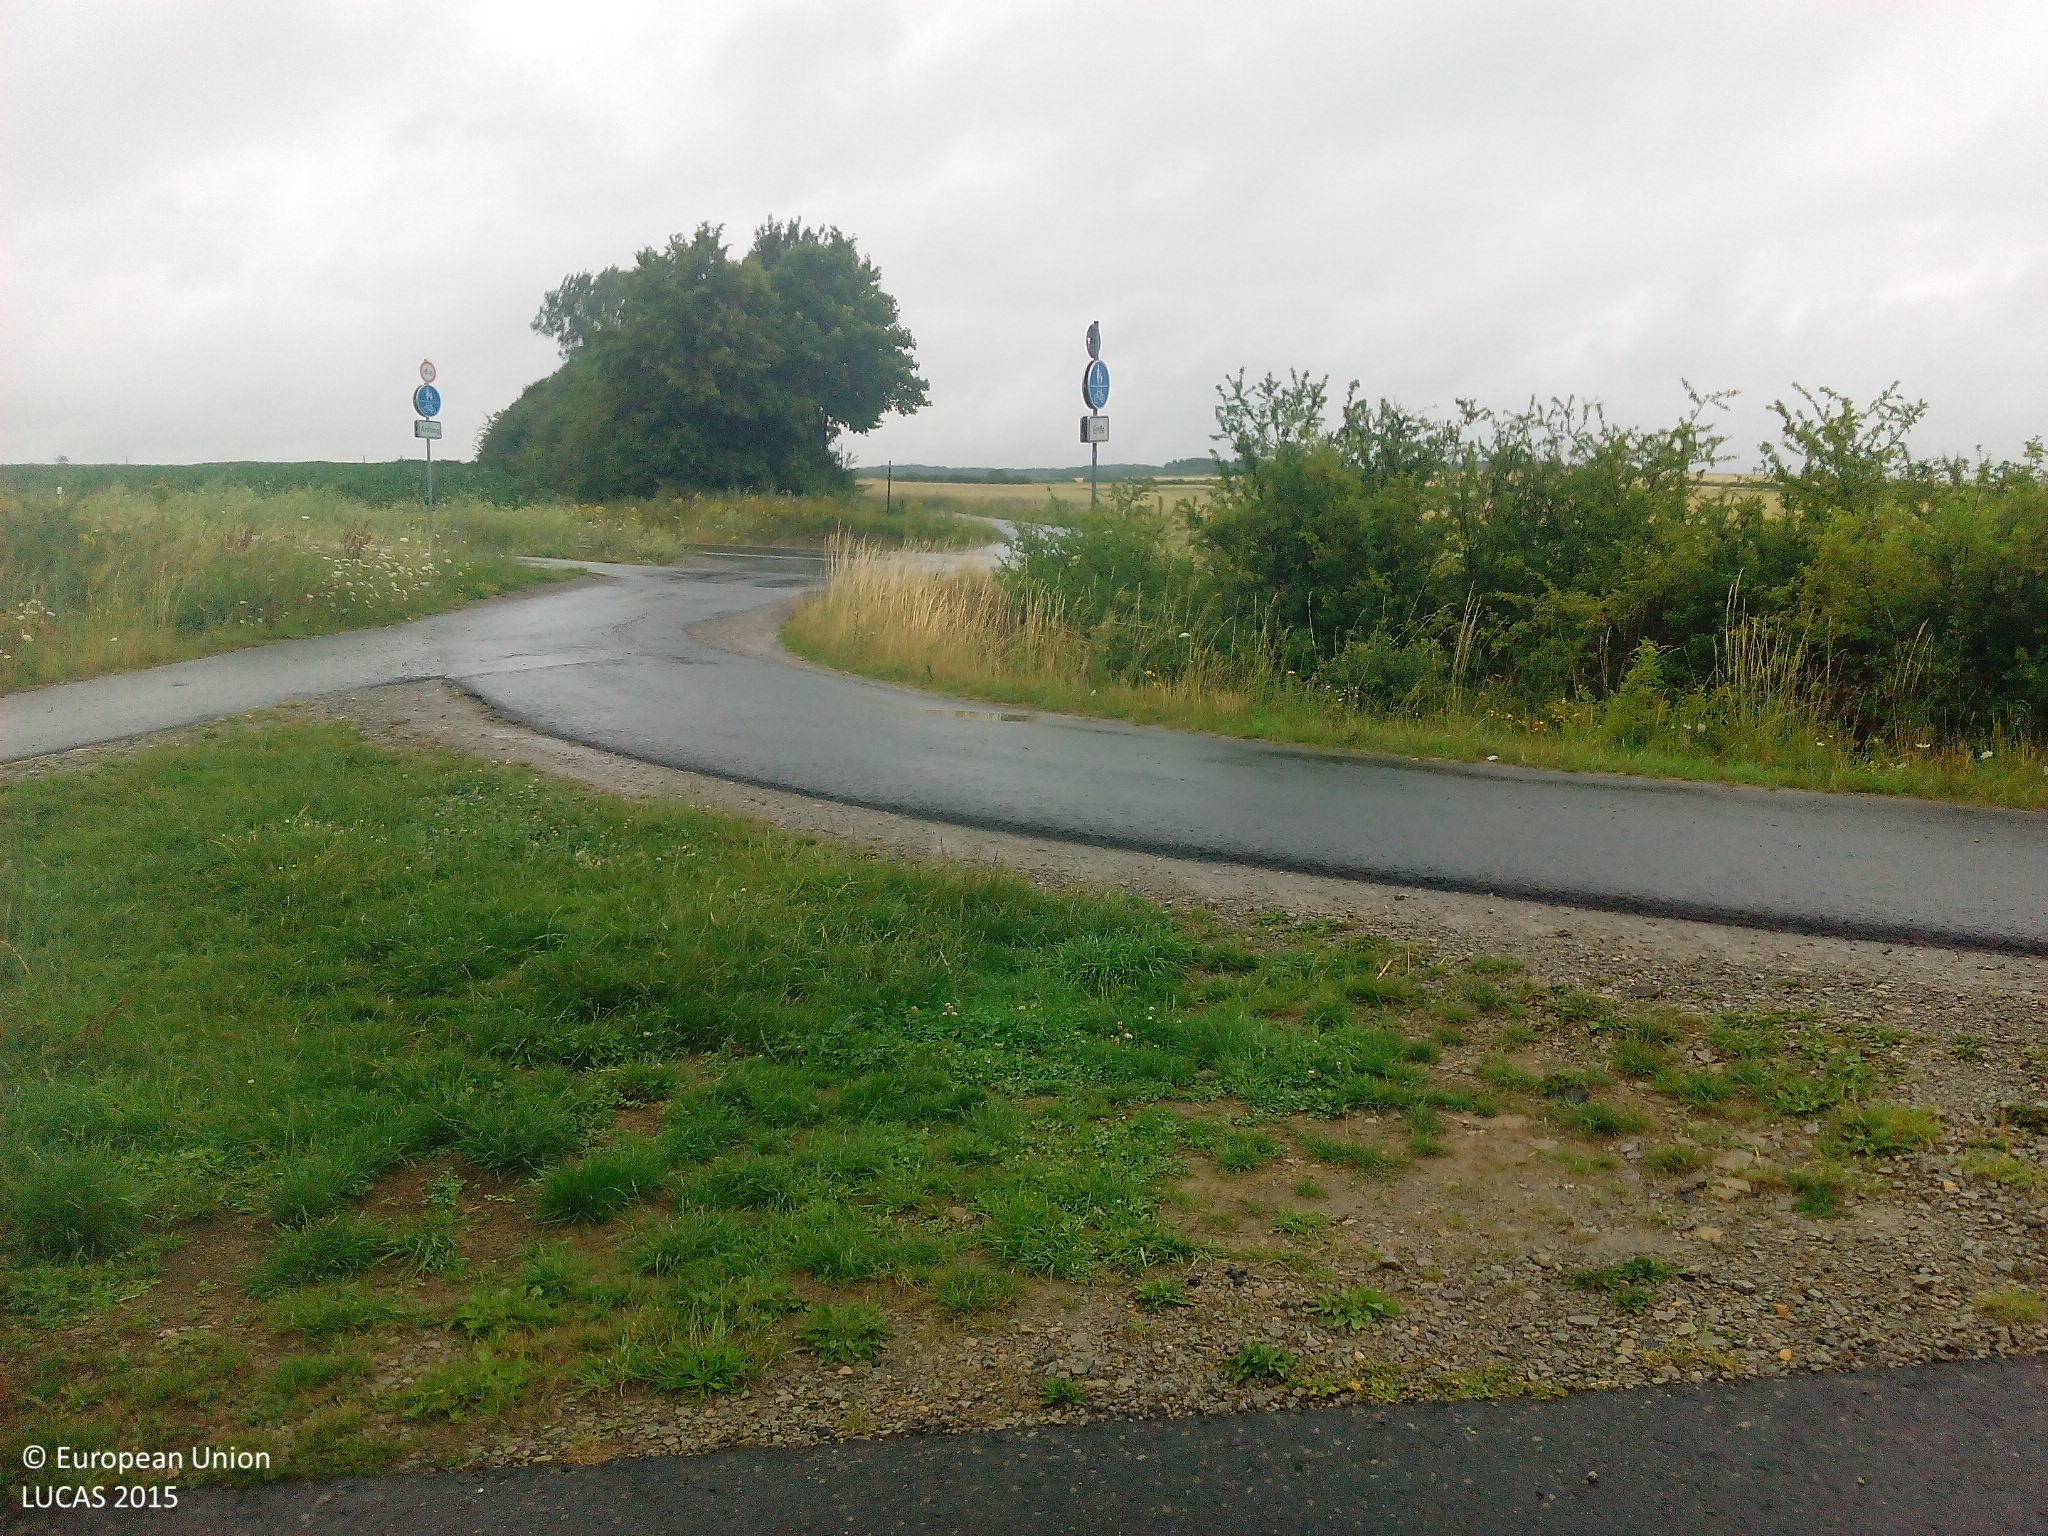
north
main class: Grassland
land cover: Grassland without tree/shrub cover
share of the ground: > 75 %
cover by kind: herbaceous plants 100 %
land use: Agriculture (excluding fallow land and kitchen gardens)
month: July
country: DE
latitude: 50.7415
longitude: 9.8442
